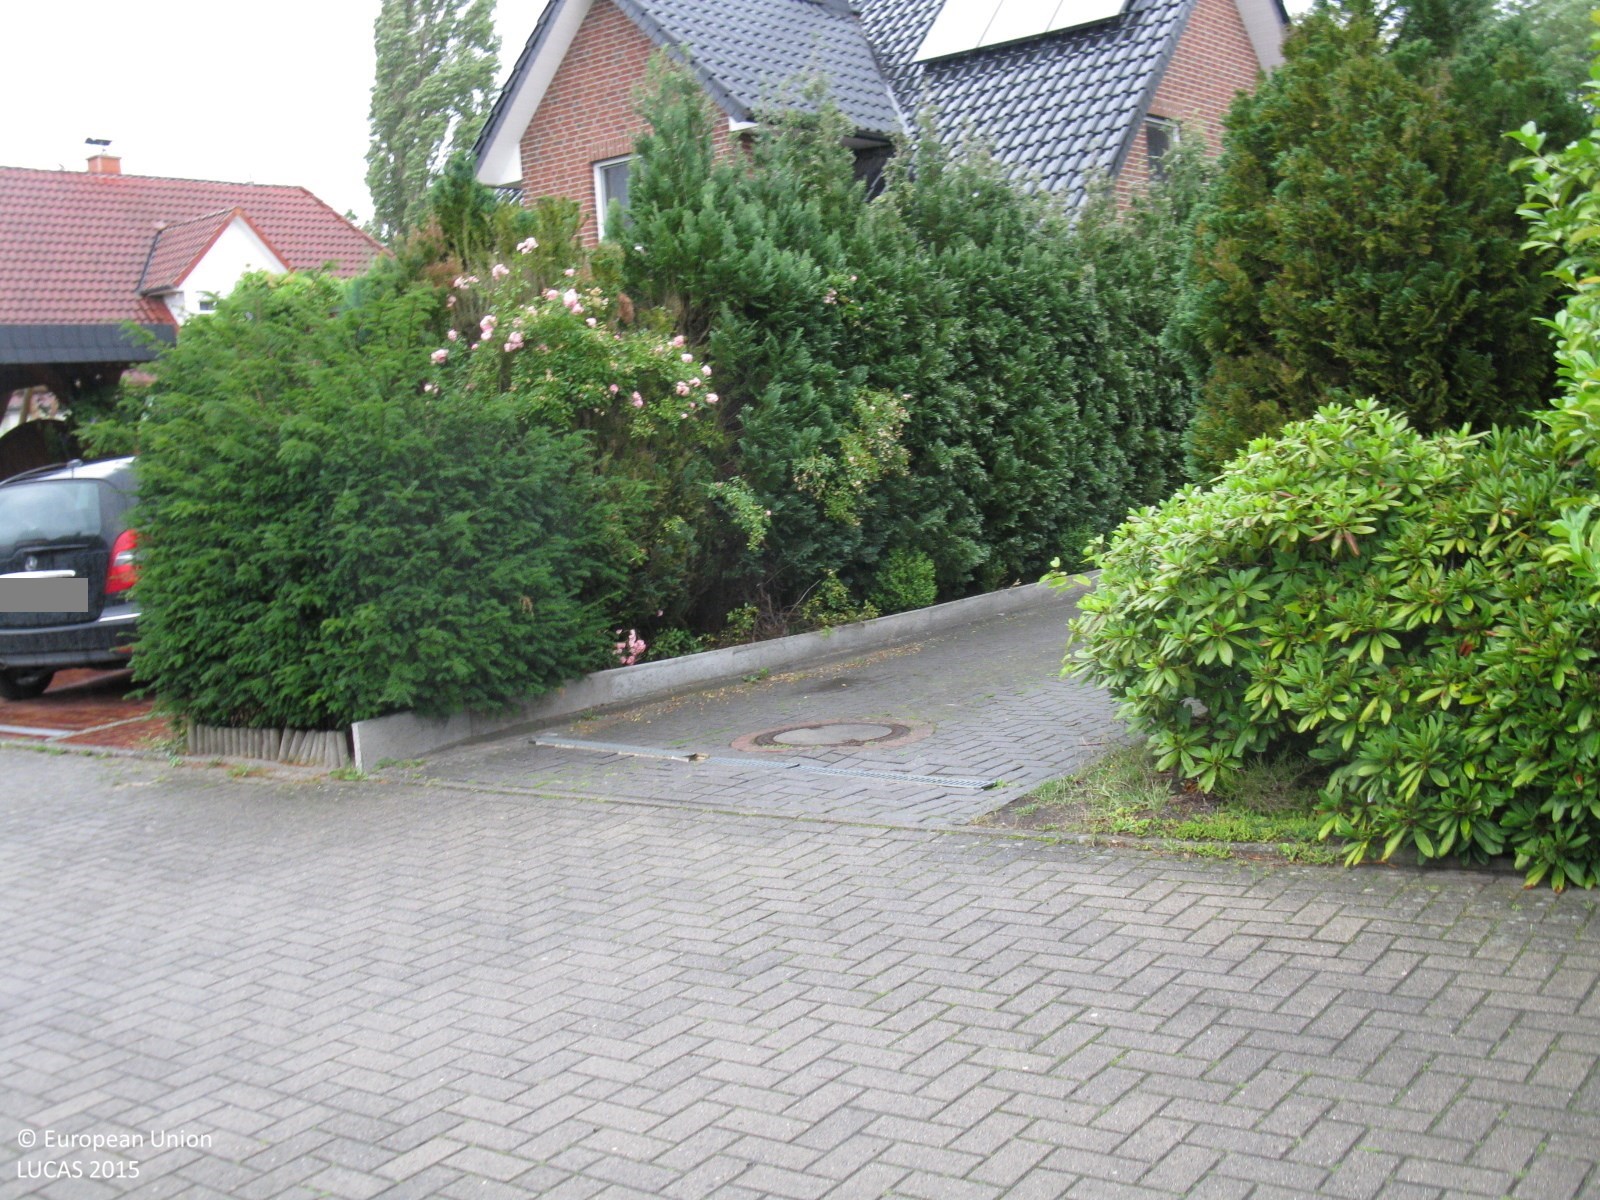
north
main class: Grassland
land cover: Grassland with sparse tree/shrub cover
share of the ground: > 75 %
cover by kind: herbaceous plants 95 %, broadleaved forest trees 5 %
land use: Residential
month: July
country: DE
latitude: 53.0881
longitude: 8.5821
